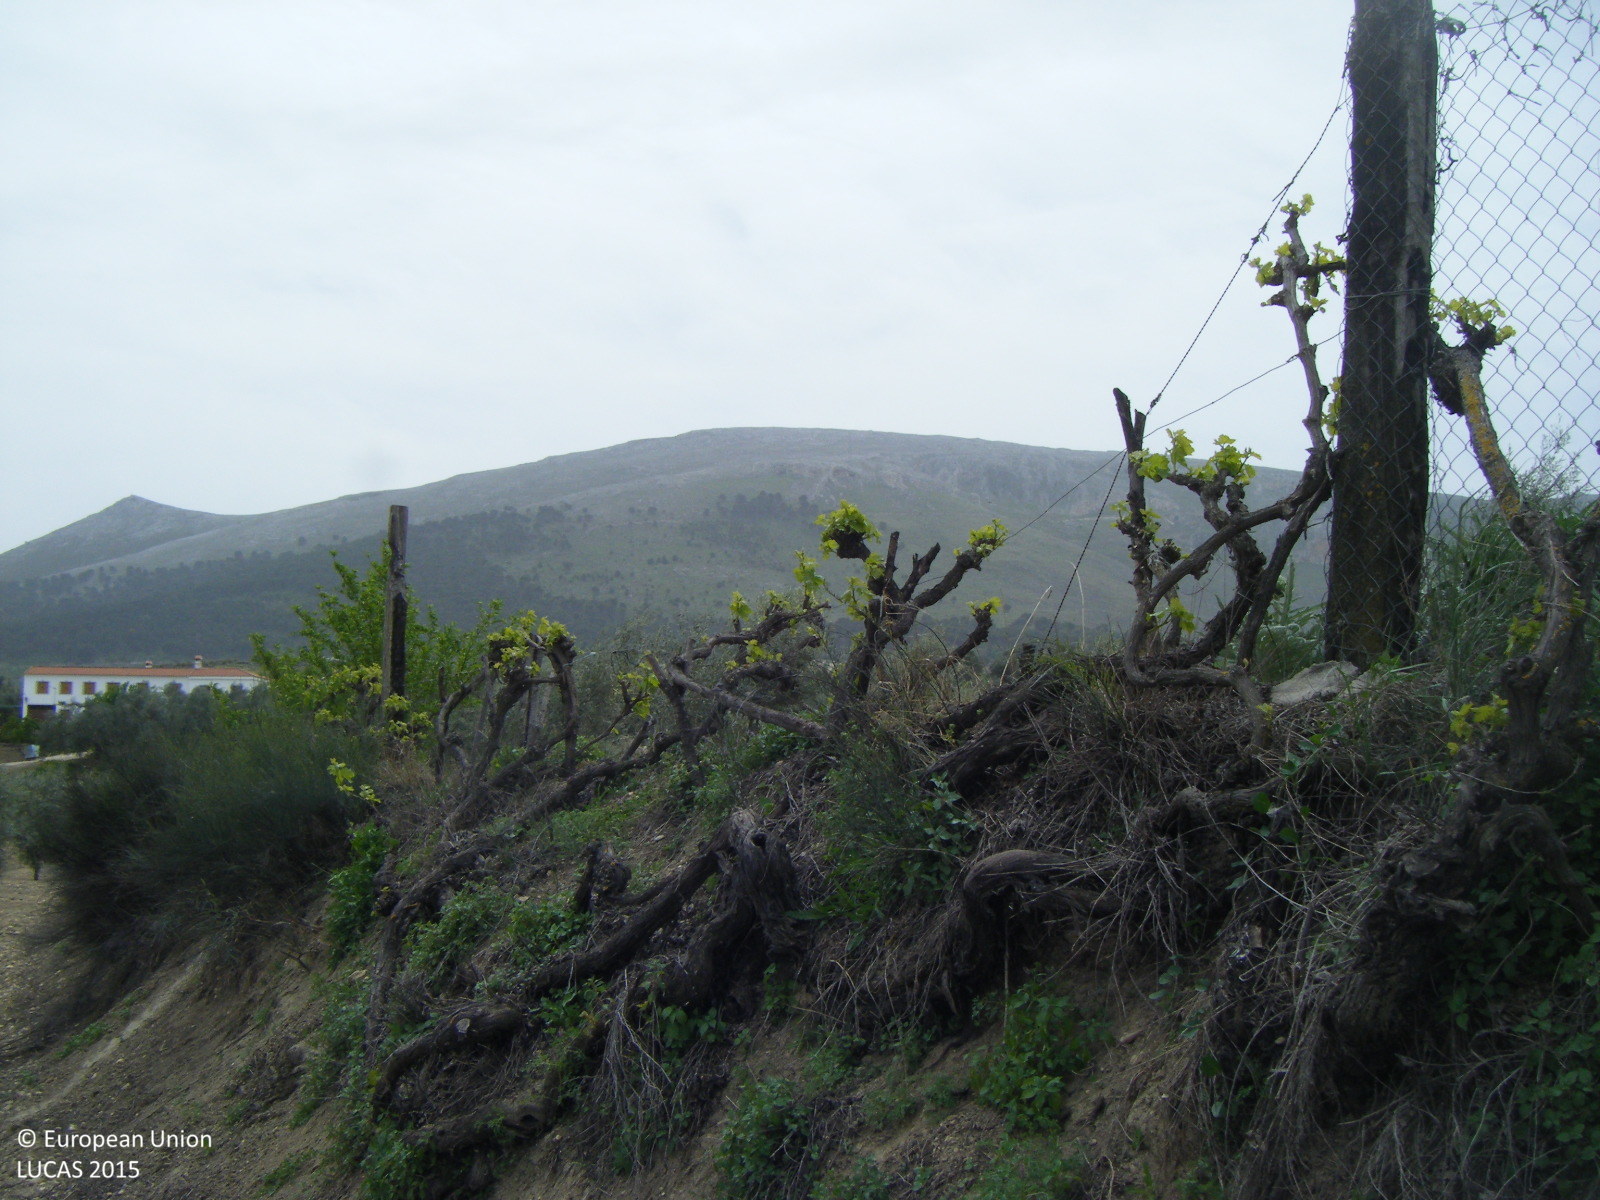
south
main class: Woodland
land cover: Broadleaved woodland
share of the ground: > 75 %
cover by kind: broadleaved forest trees 95 %, coniferous forest trees 5 %
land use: Residential
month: April
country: ES
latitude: 37.1761
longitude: -4.1752
